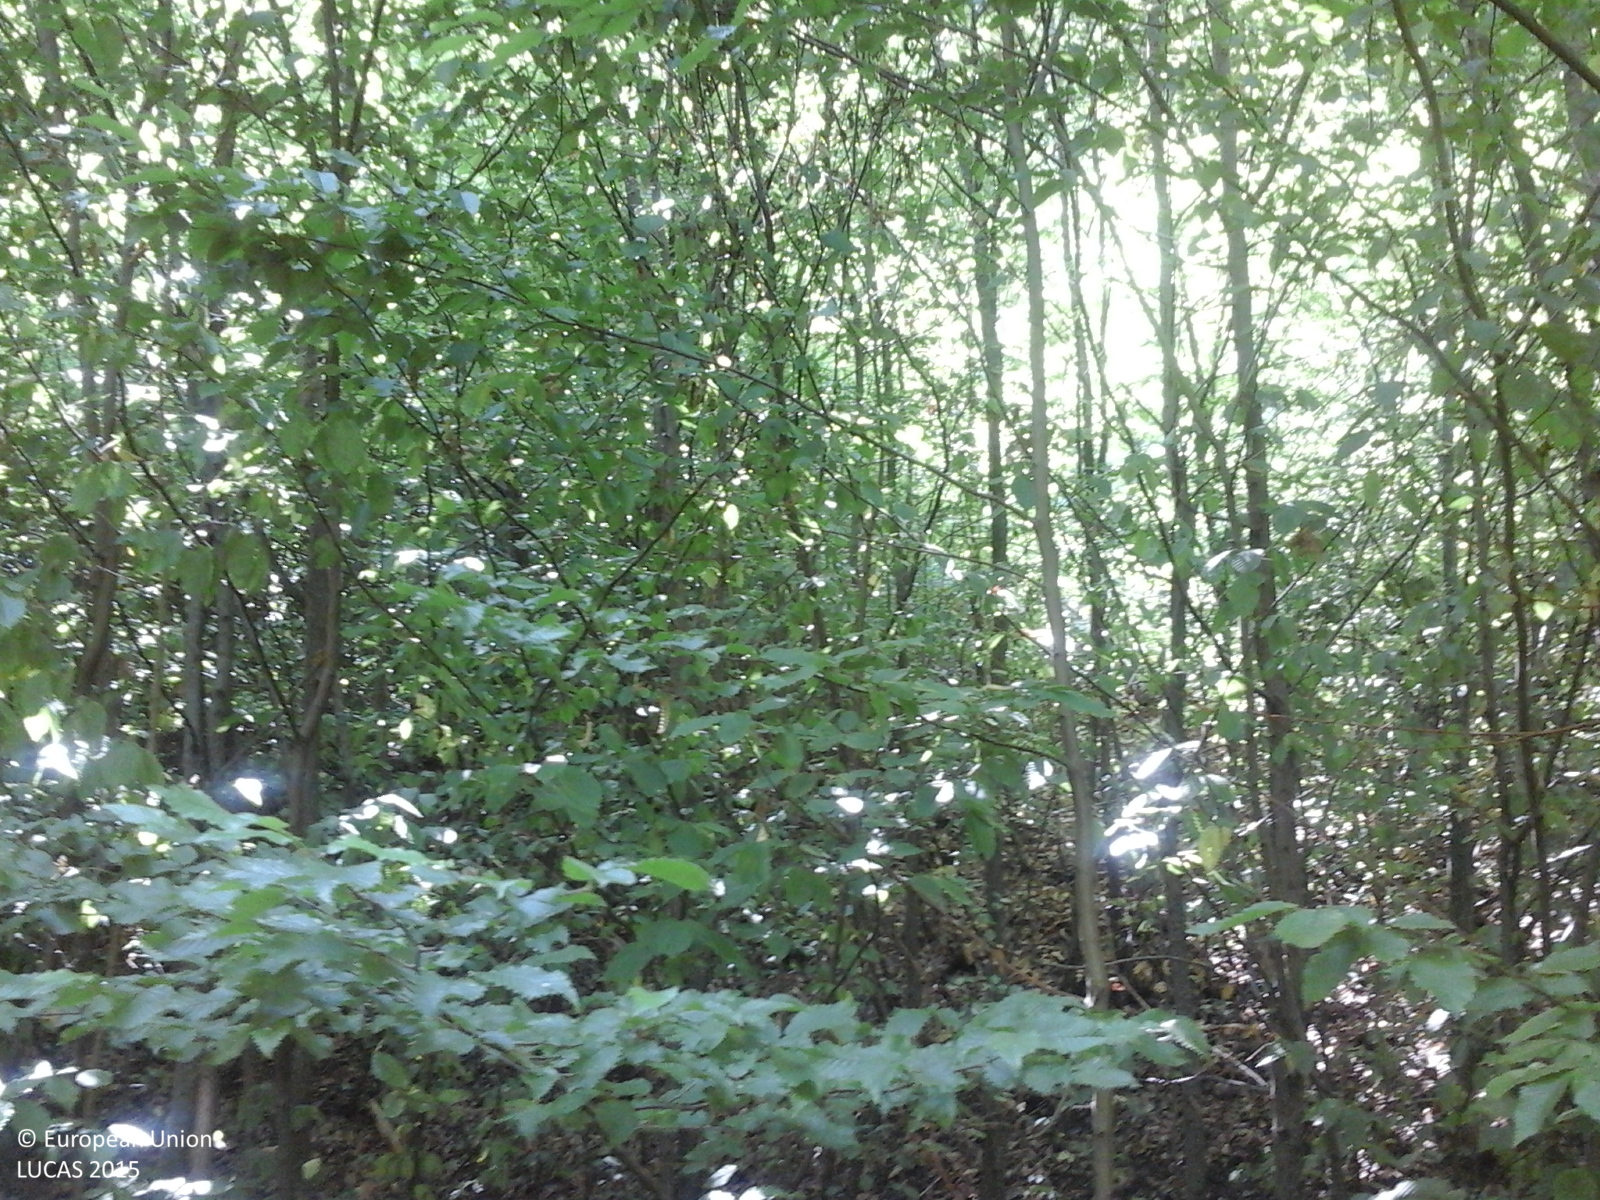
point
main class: Woodland
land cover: Broadleaved woodland
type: acidophilous oak and oak-birch forest
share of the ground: > 75 %
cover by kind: broadleaved forest trees 100 %
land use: Forestry
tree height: > 5 m
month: July
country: RO
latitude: 44.9066
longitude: 24.4487
